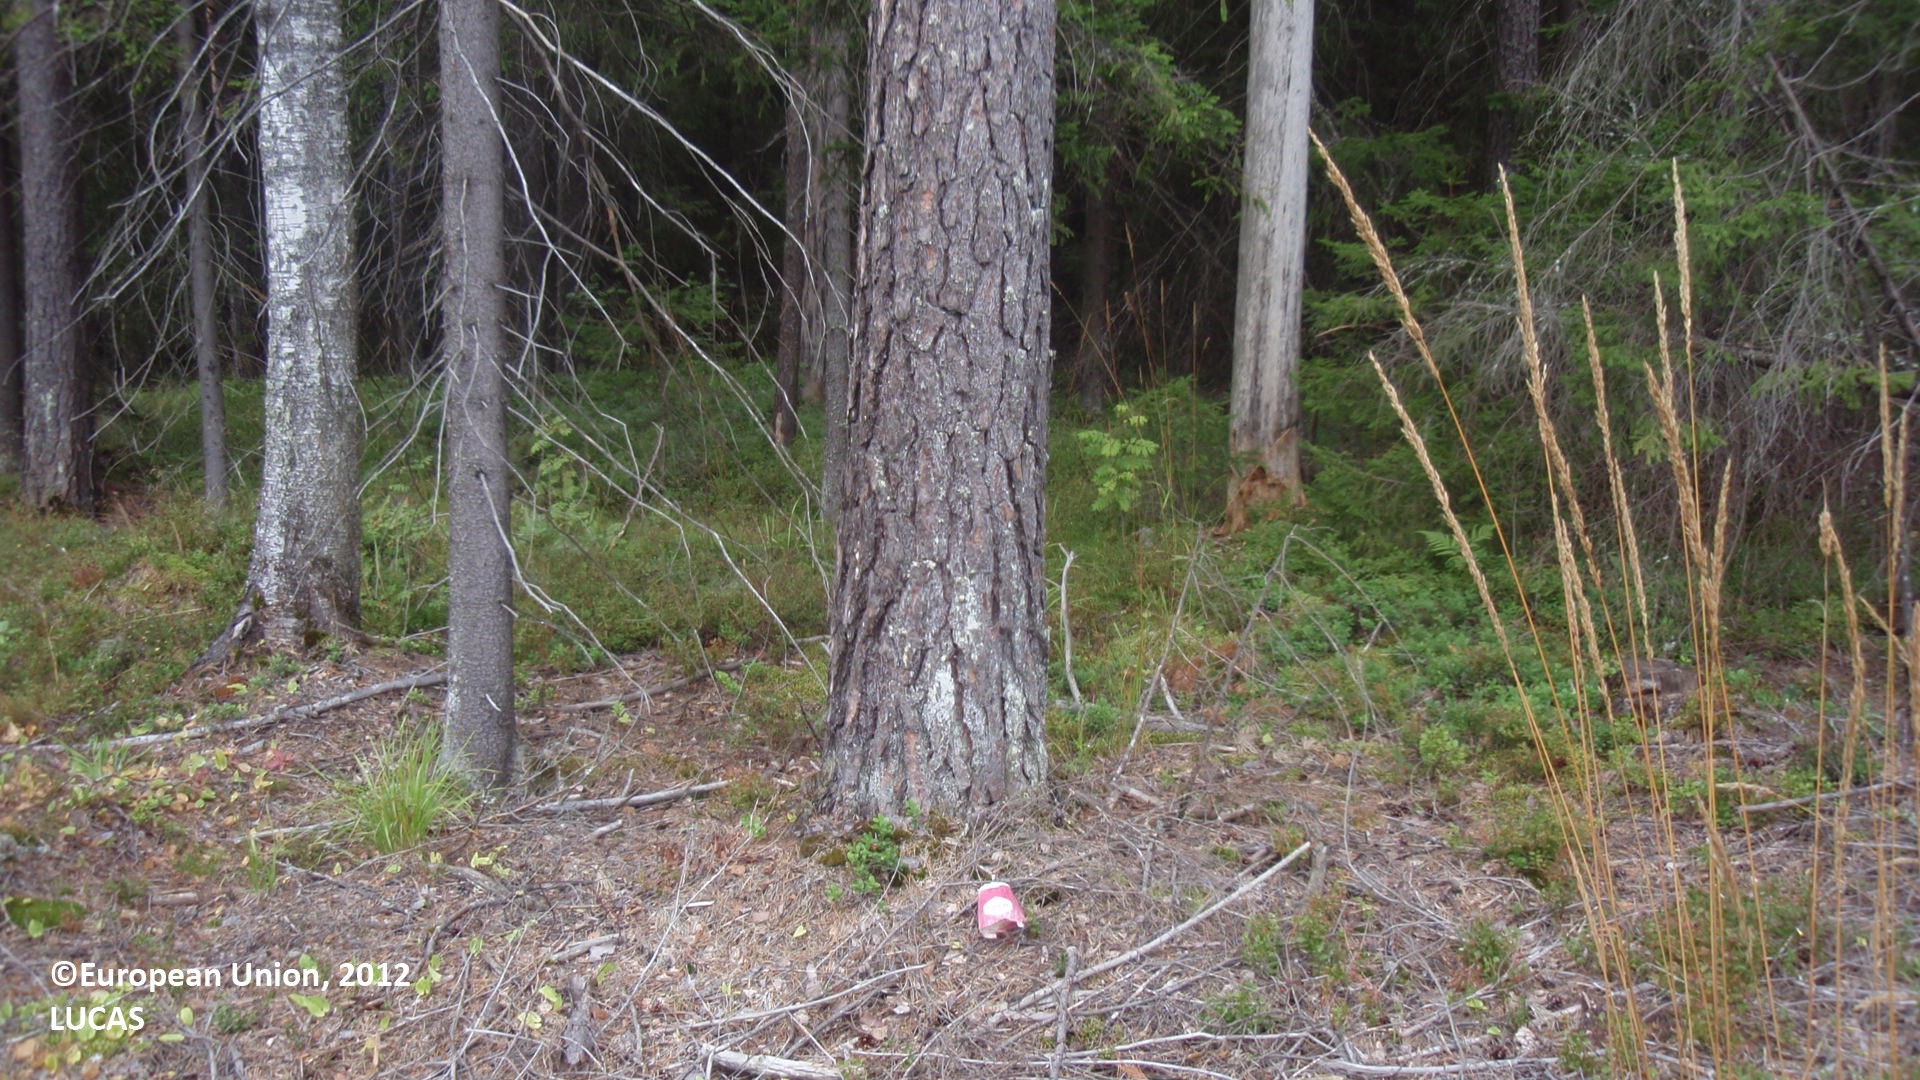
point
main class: Woodland
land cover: Spruce dominated mixed woodland
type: boreal forest
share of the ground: 50 - 75 %
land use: Forestry
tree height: > 5 m
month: August
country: FI
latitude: 60.7248
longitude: 27.3198
